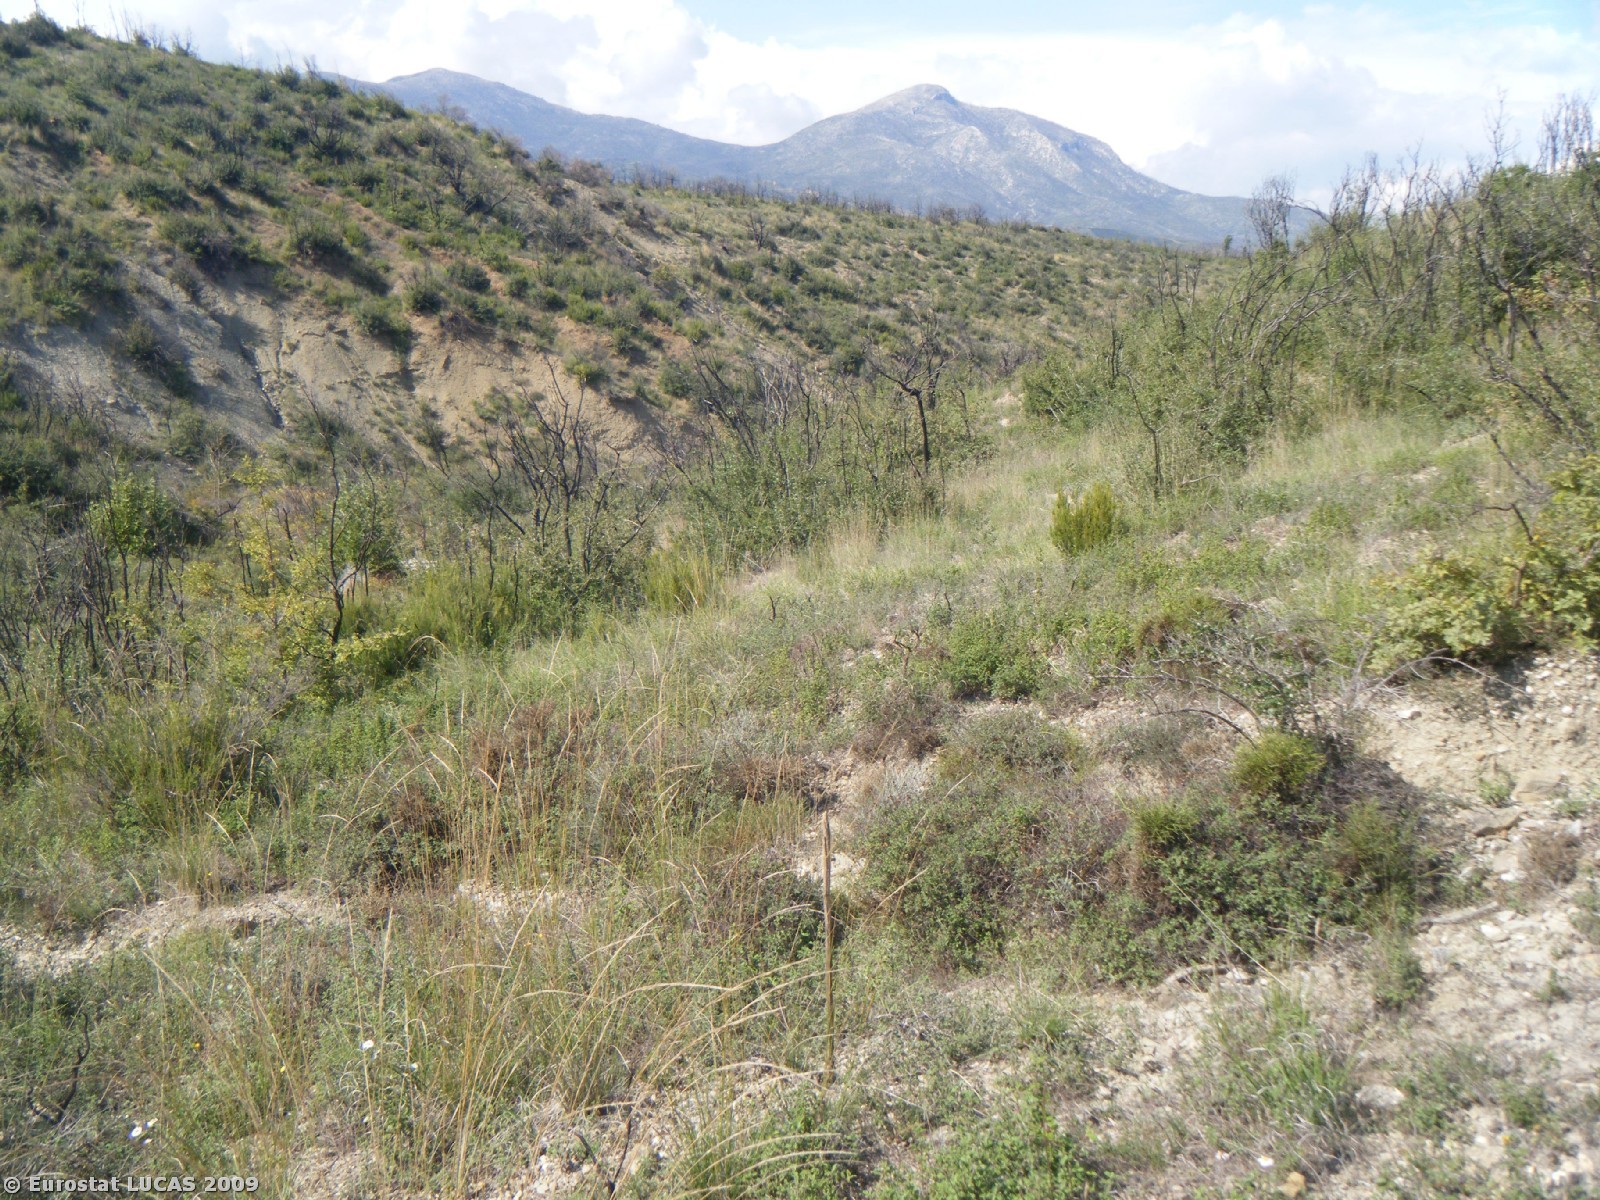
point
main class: Shrubland
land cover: Shrubland without tree cover
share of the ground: > 75 %
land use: Unused
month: October
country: GR
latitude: 37.2383
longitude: 22.1646
